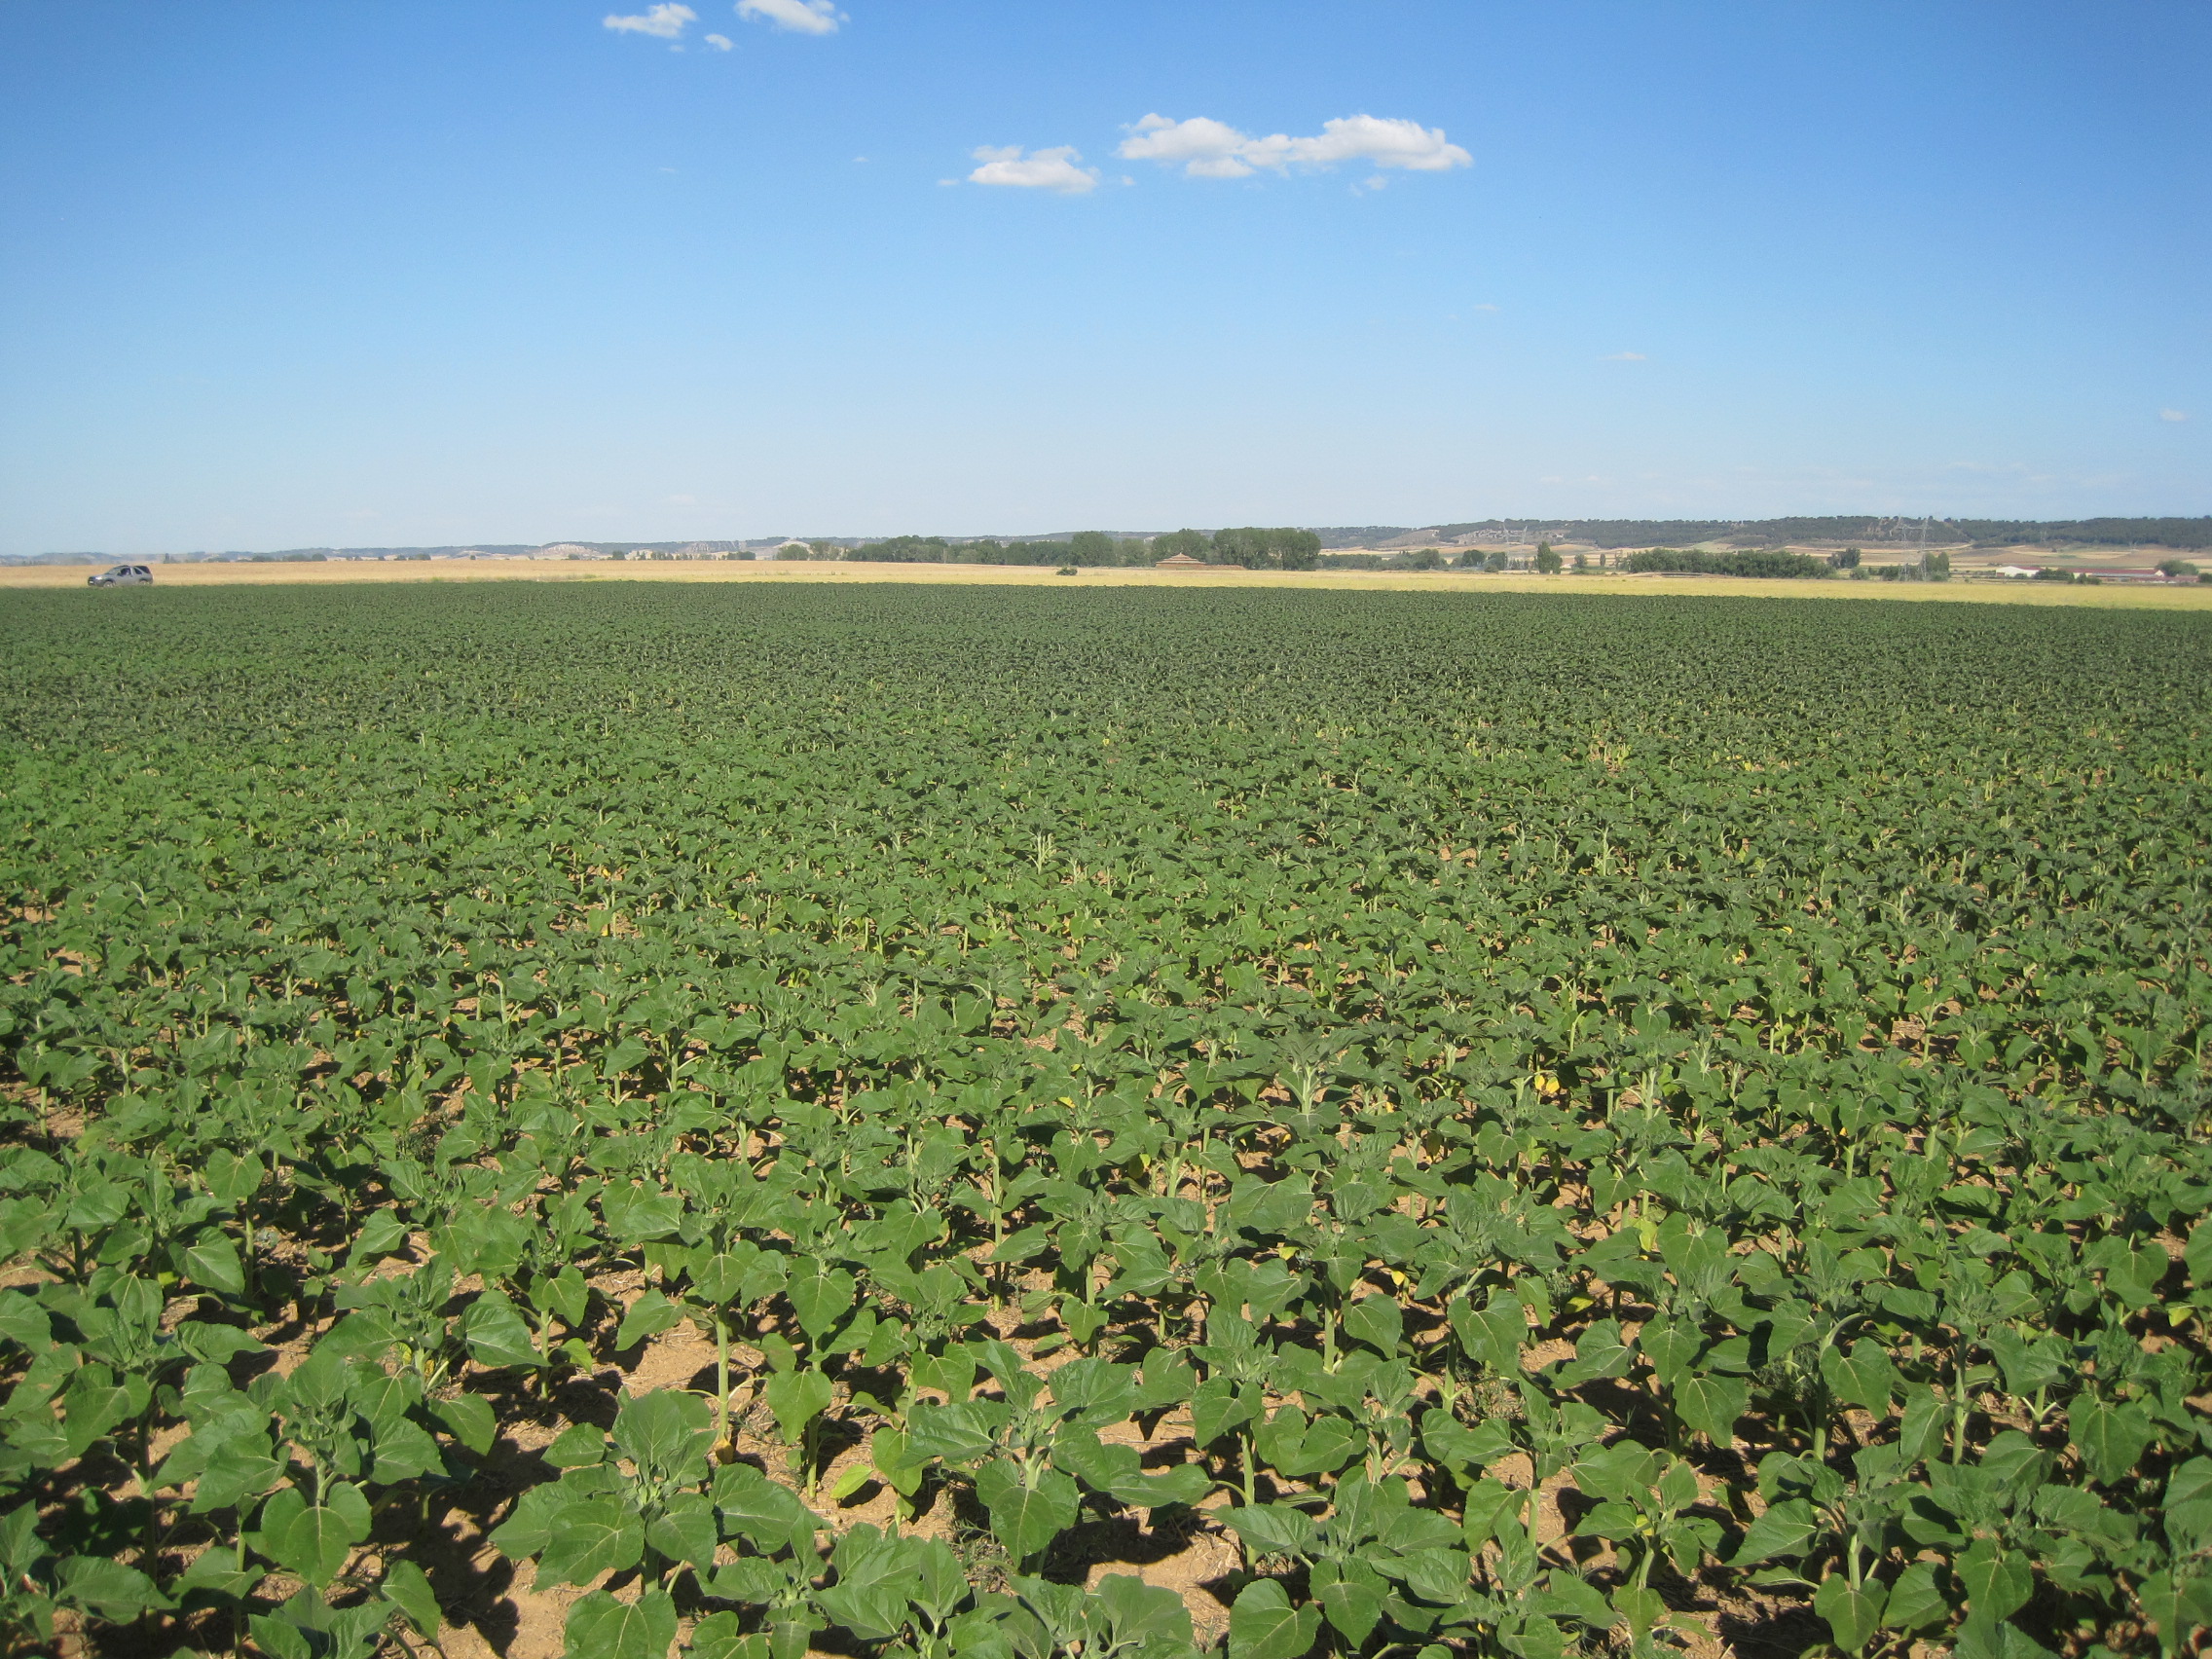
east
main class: Cropland
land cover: Sunflower
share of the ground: > 75 %
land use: Agriculture (excluding fallow land and kitchen gardens)
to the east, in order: Sunflower; Grass margins; Common wheat; Grass margins; Tracks; Grass margins; Barley
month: June
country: ES
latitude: 41.7917
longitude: -5.2059
